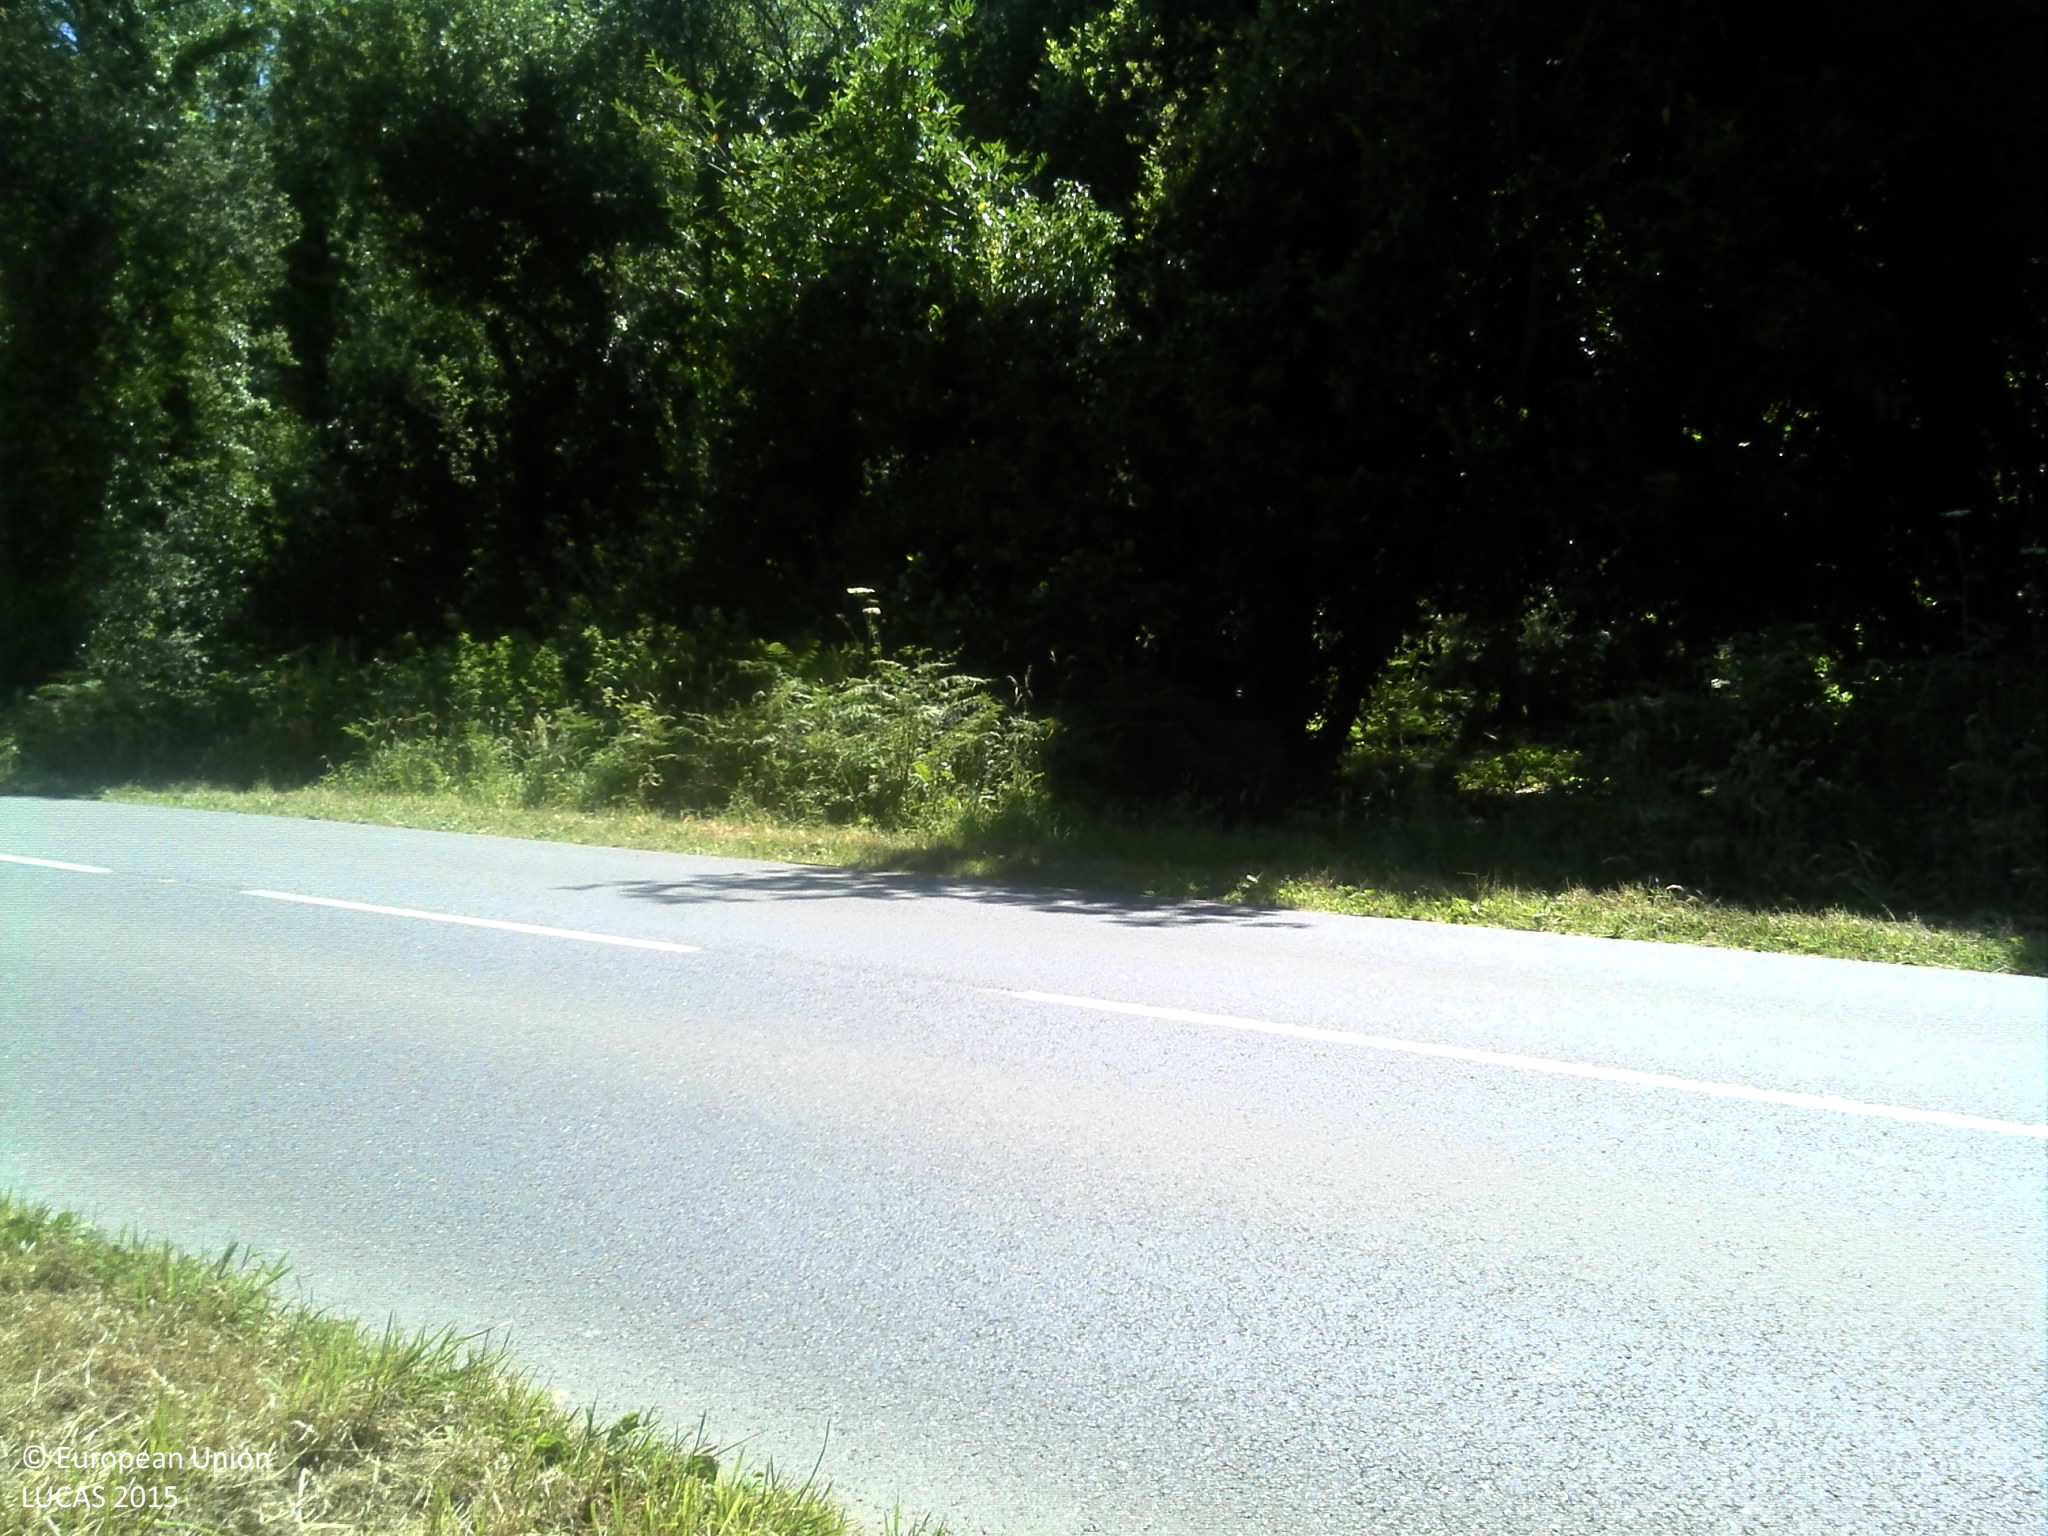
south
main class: Woodland
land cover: Broadleaved woodland
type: mesophytic deciduous forest
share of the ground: > 75 %
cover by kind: broadleaved forest trees 100 %
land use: Forestry
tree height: > 5 m
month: July
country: FR
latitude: 48.6698
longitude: -3.7587
